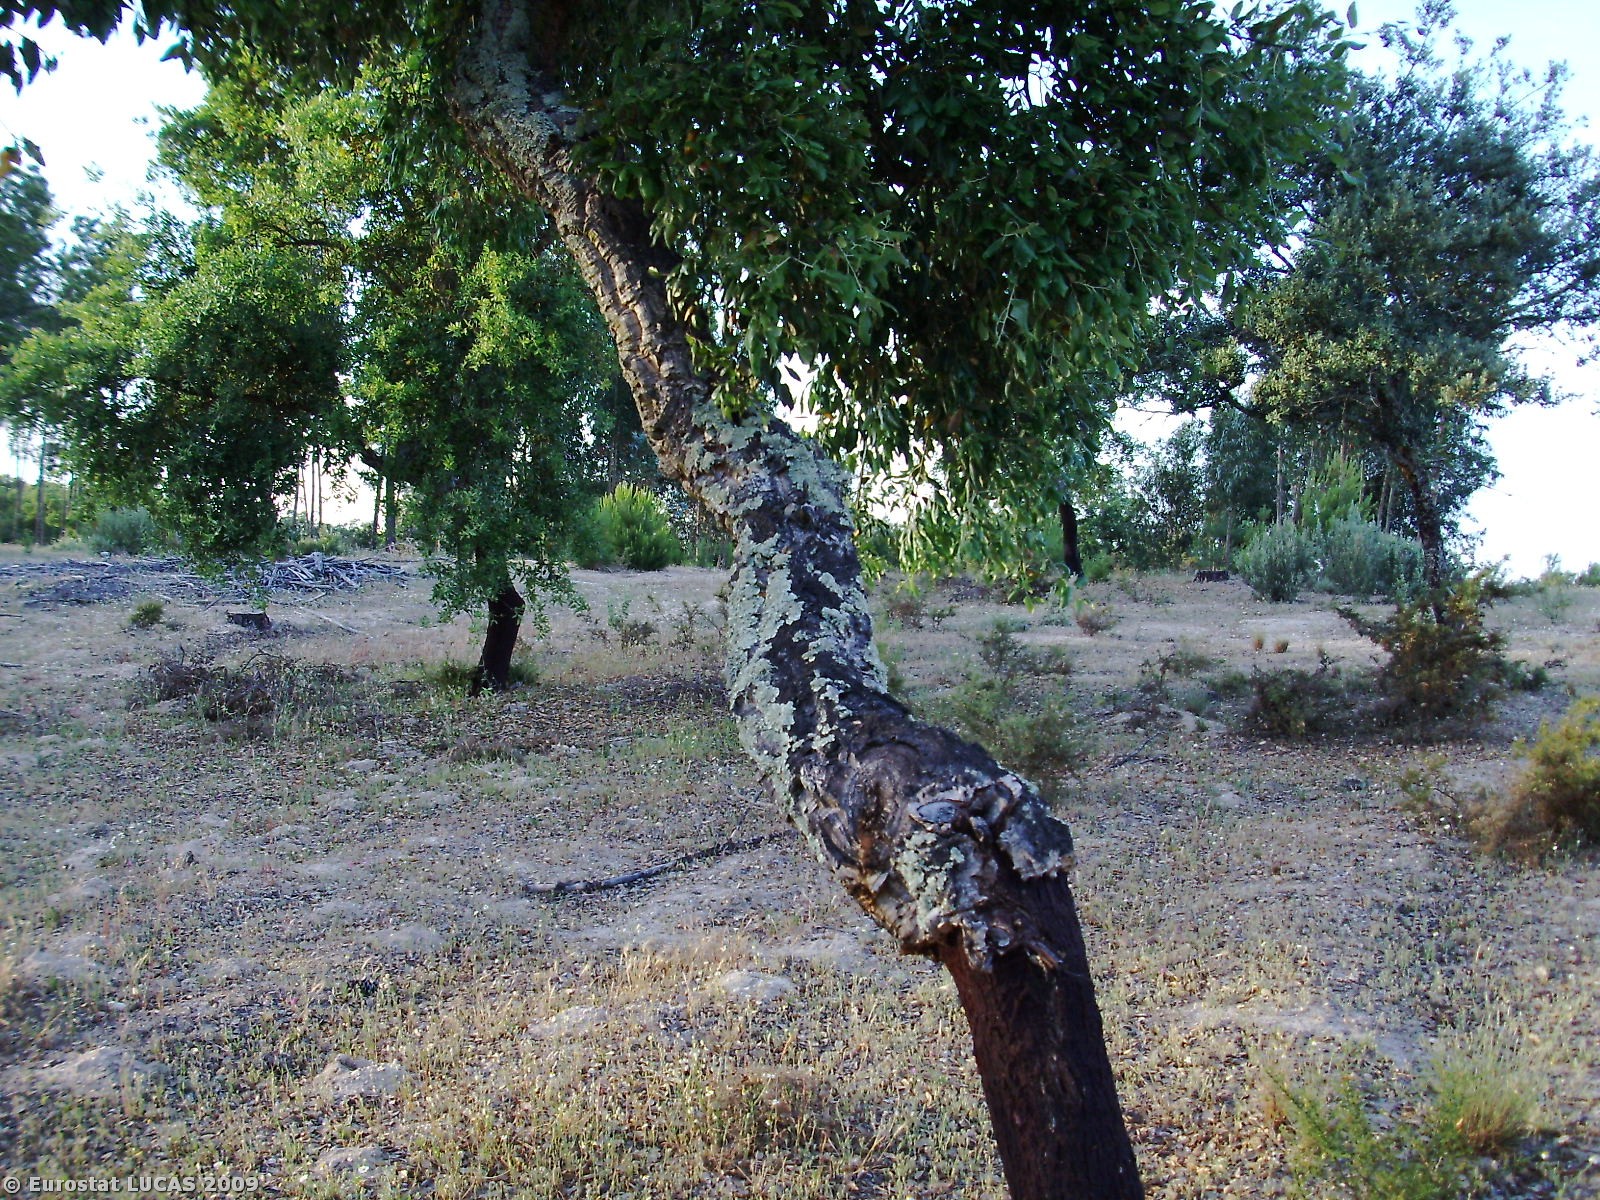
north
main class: Woodland
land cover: Broadleaved woodland
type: broadleaved evergreen forest
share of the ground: 50 - 75 %
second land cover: Spontaneously vegetated surfaces
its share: 25 - 50 %
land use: Forestry
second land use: Fallow land
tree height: > 5 m
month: May
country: PT
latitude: 39.1116
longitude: -8.0601
